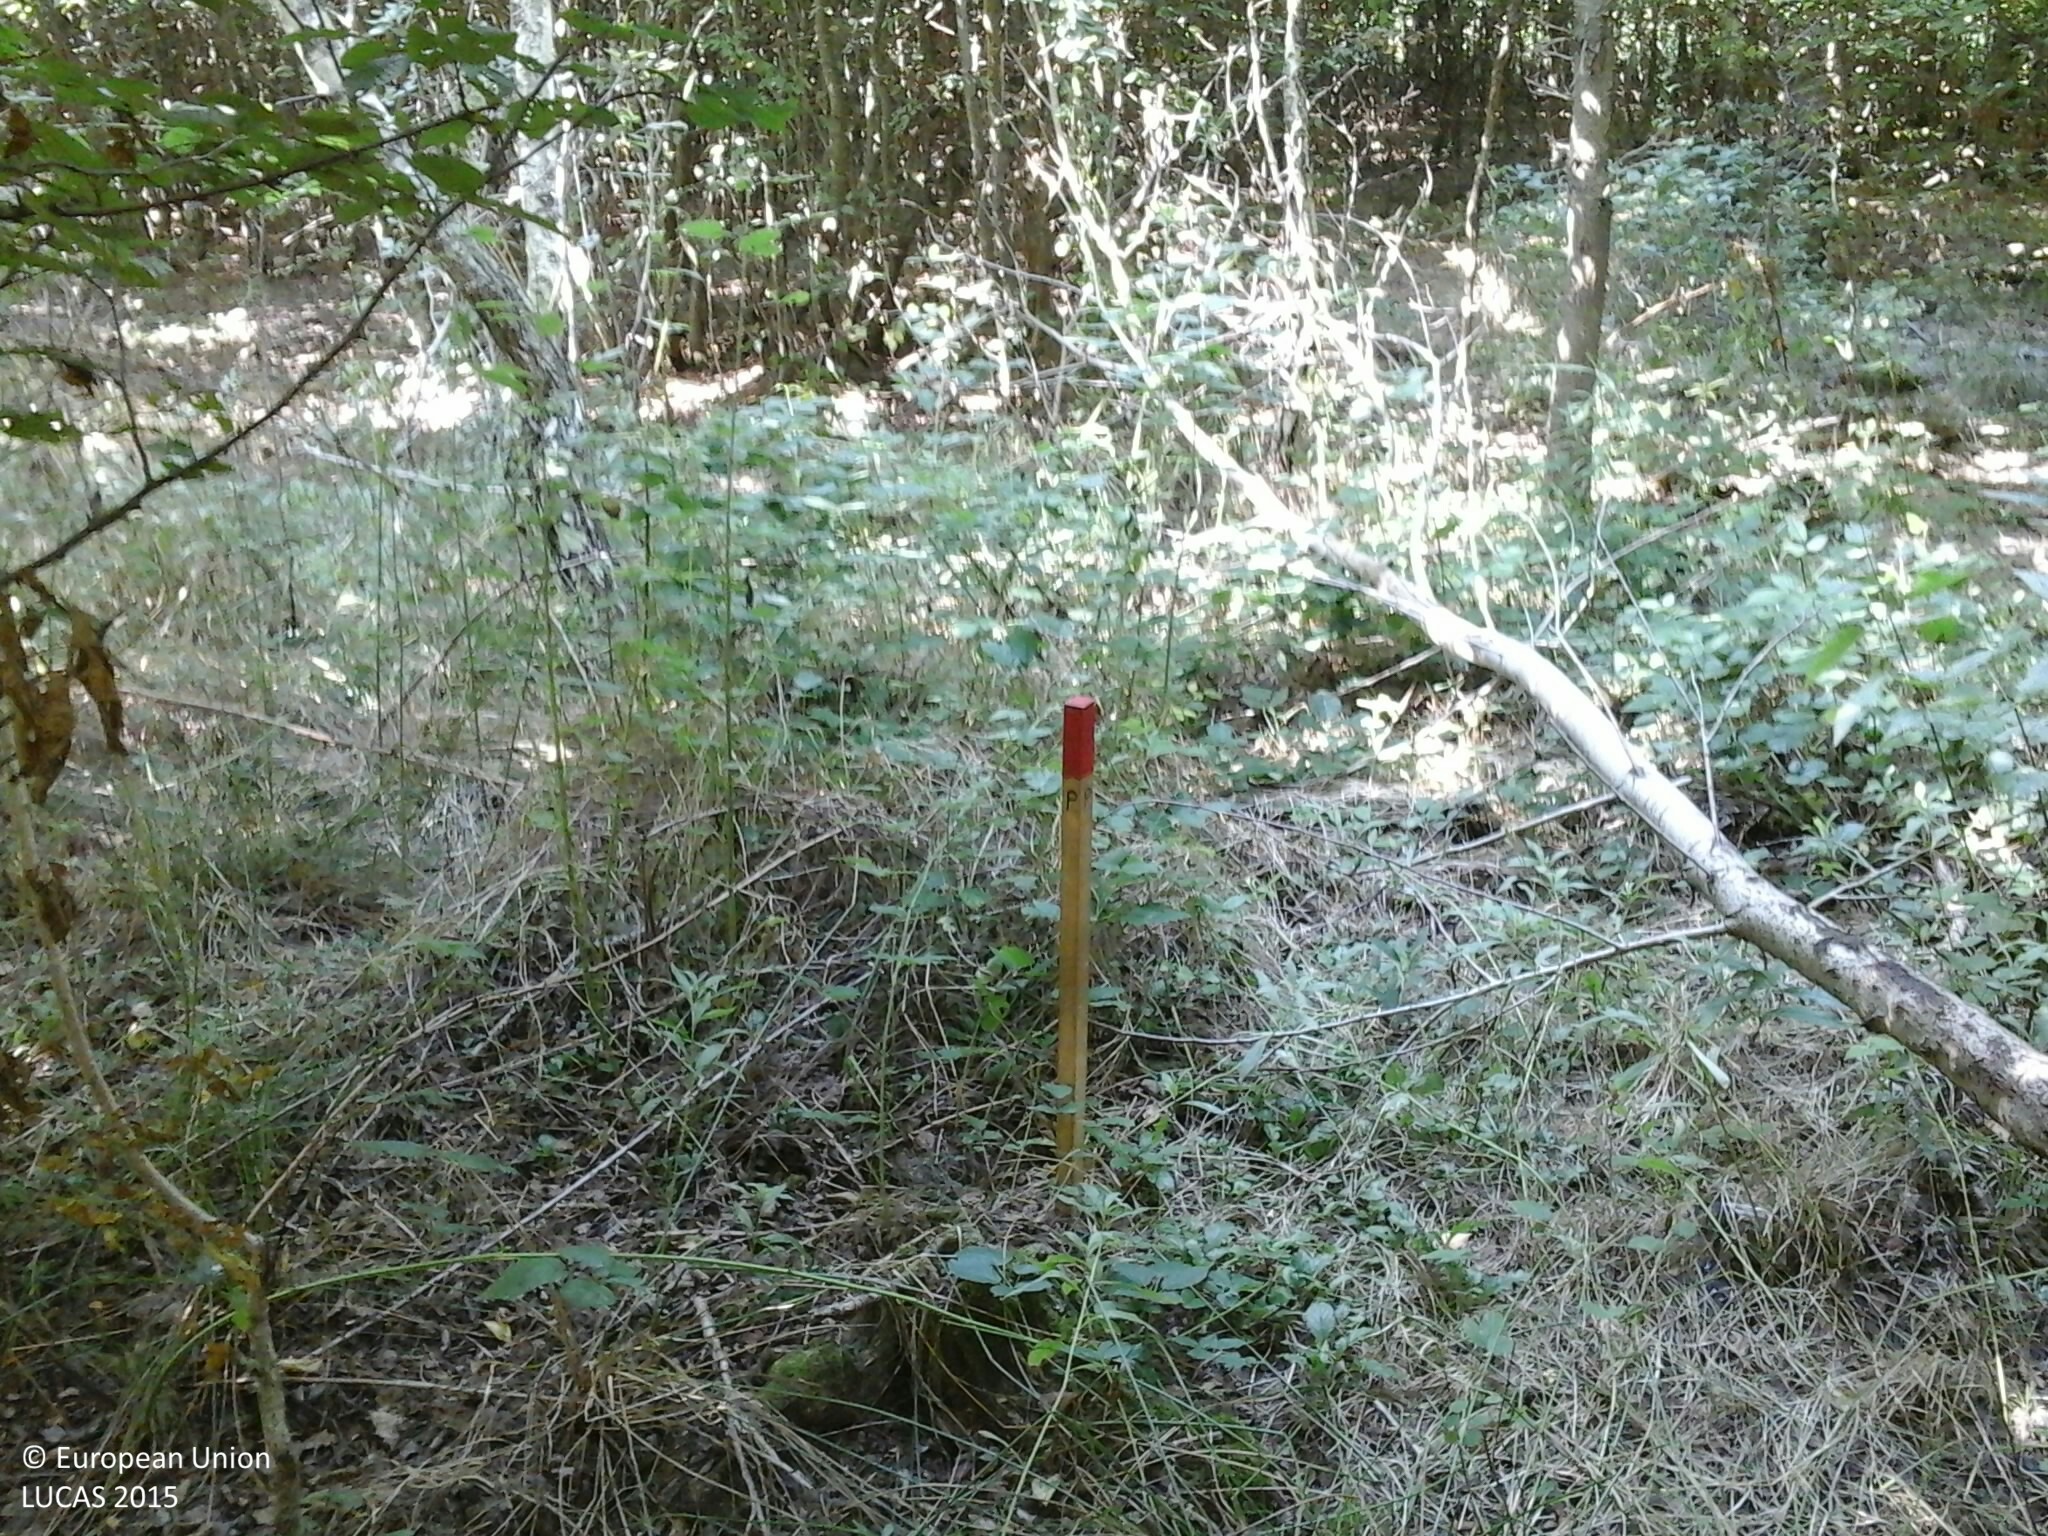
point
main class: Woodland
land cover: Broadleaved woodland
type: beech forest
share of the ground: > 75 %
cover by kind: broadleaved forest trees 80 %, shrubs 10 %, herbaceous plants 10 %
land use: Forestry
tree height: > 5 m
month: July
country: HU
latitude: 46.9854
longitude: 16.4842
